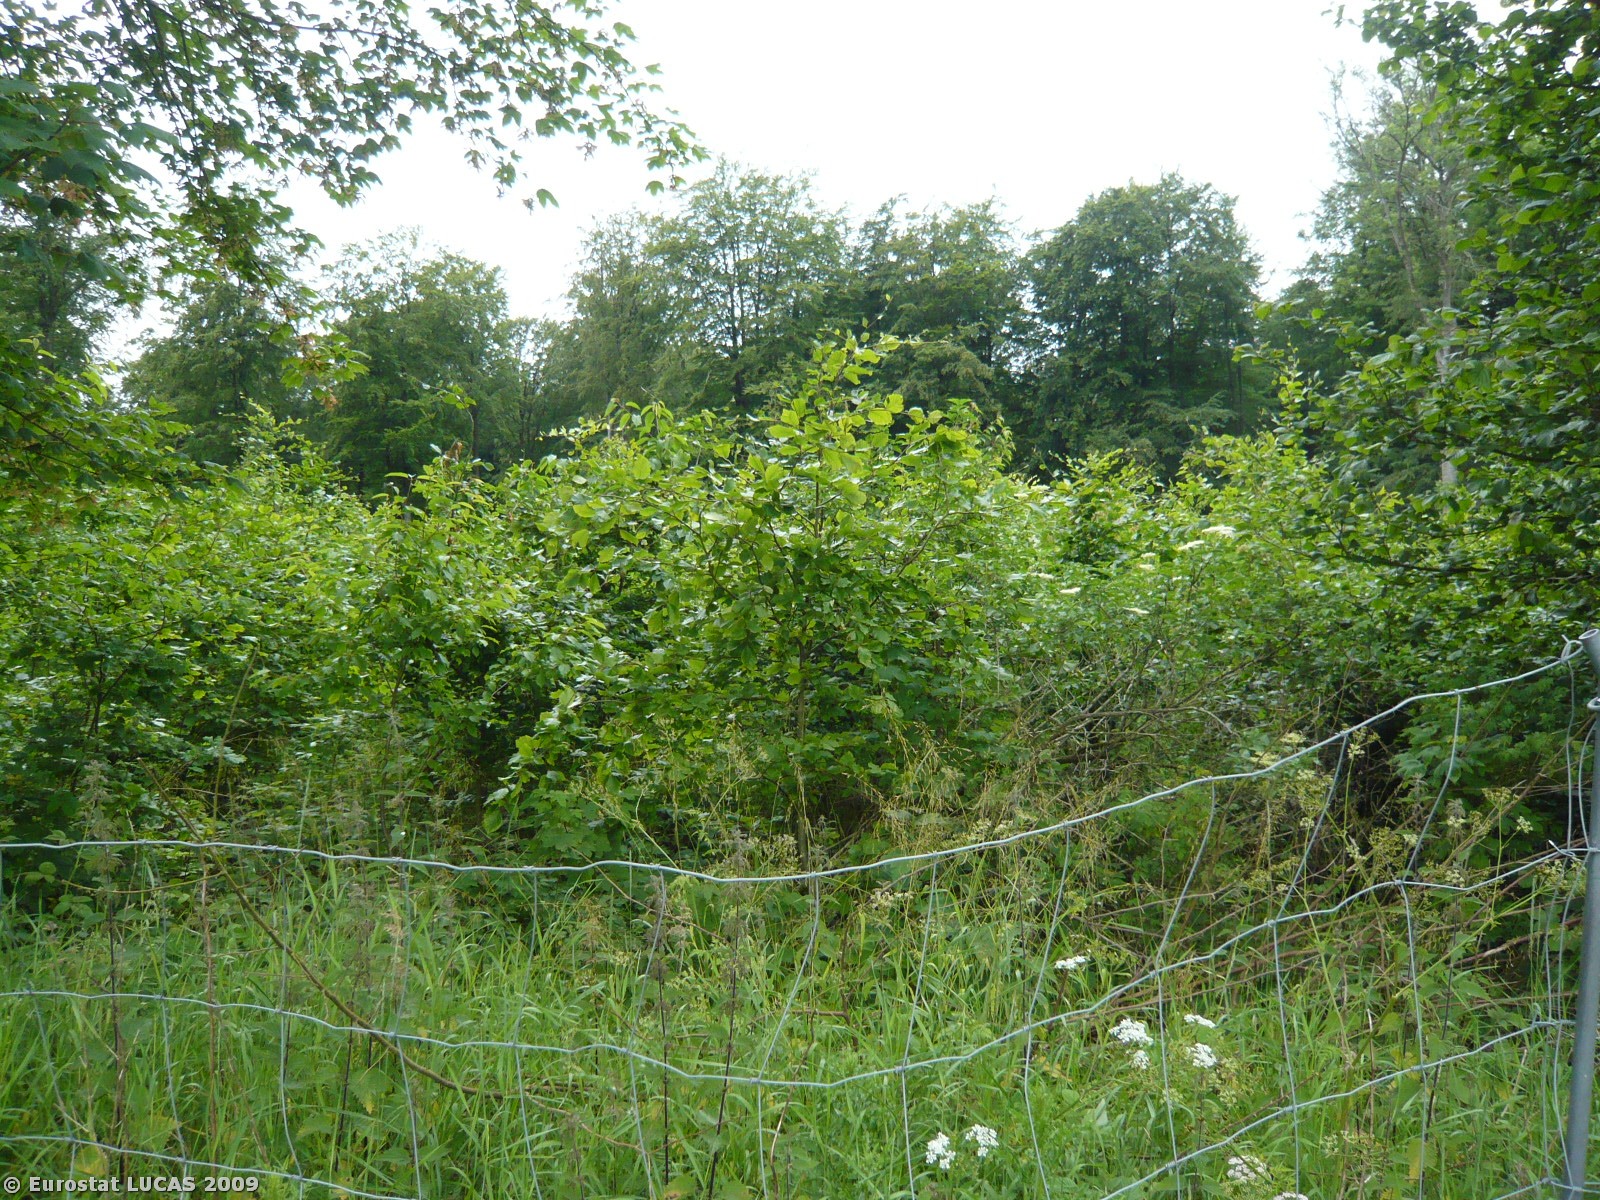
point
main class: Woodland
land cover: Broadleaved woodland
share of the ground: > 75 %
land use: Forestry
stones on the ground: < 10 %
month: June
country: DK
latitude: 55.1616
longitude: 10.6430
